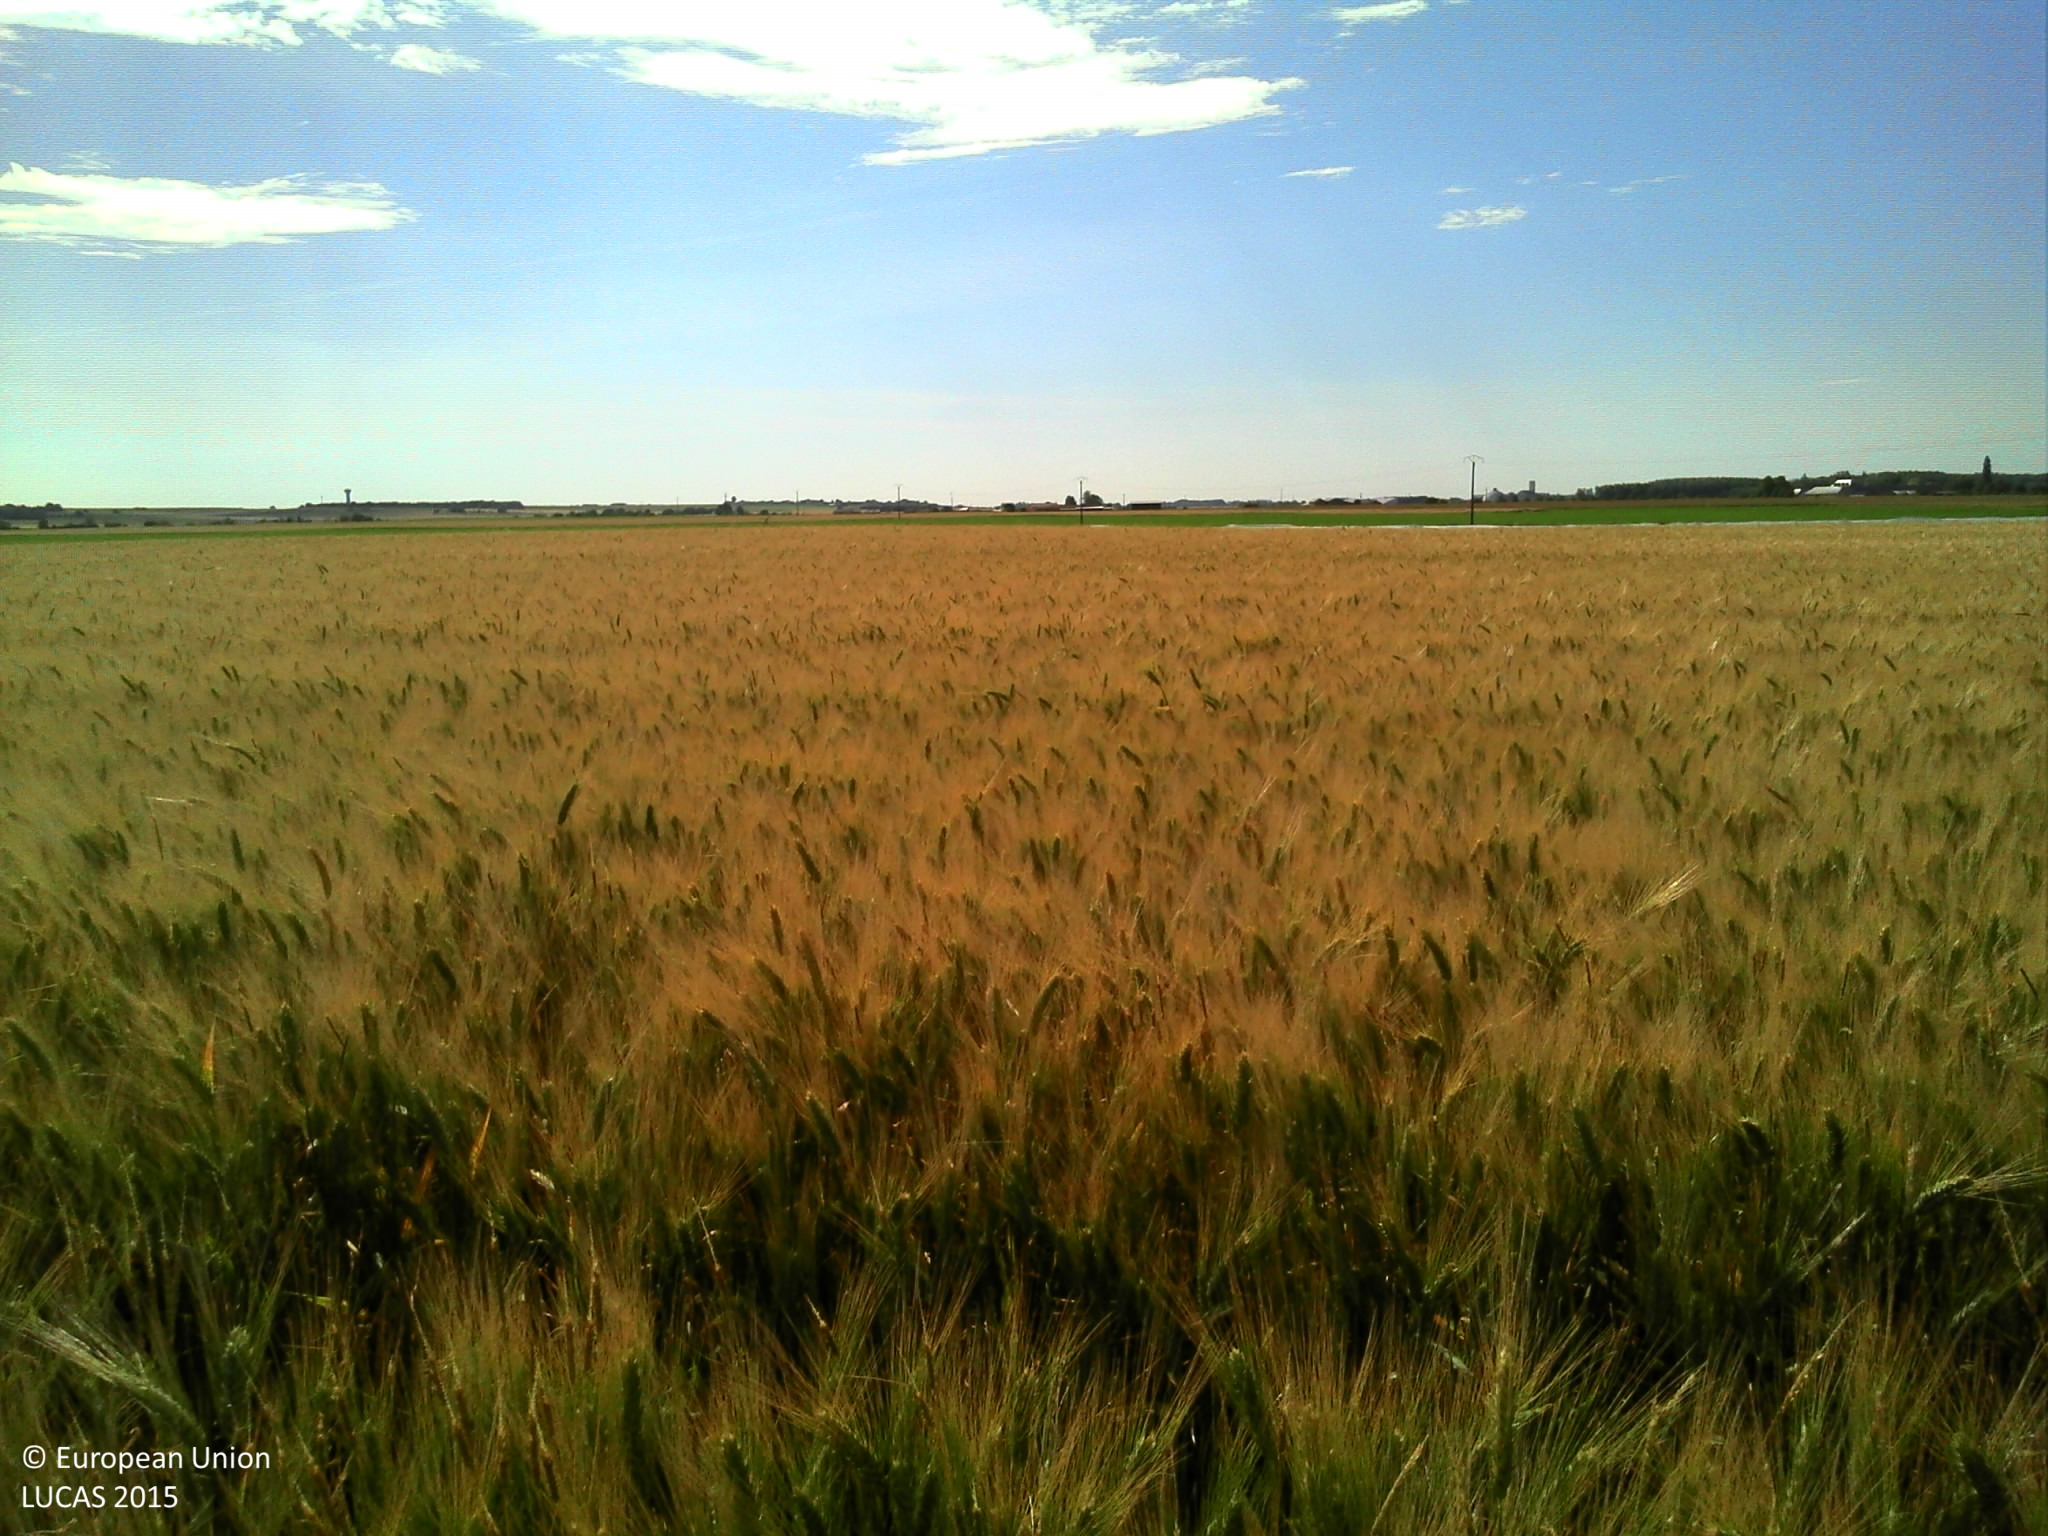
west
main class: Cropland
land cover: Barley
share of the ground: > 75 %
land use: Agriculture (excluding fallow land and kitchen gardens)
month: June
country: FR
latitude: 46.8191
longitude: 0.1347
